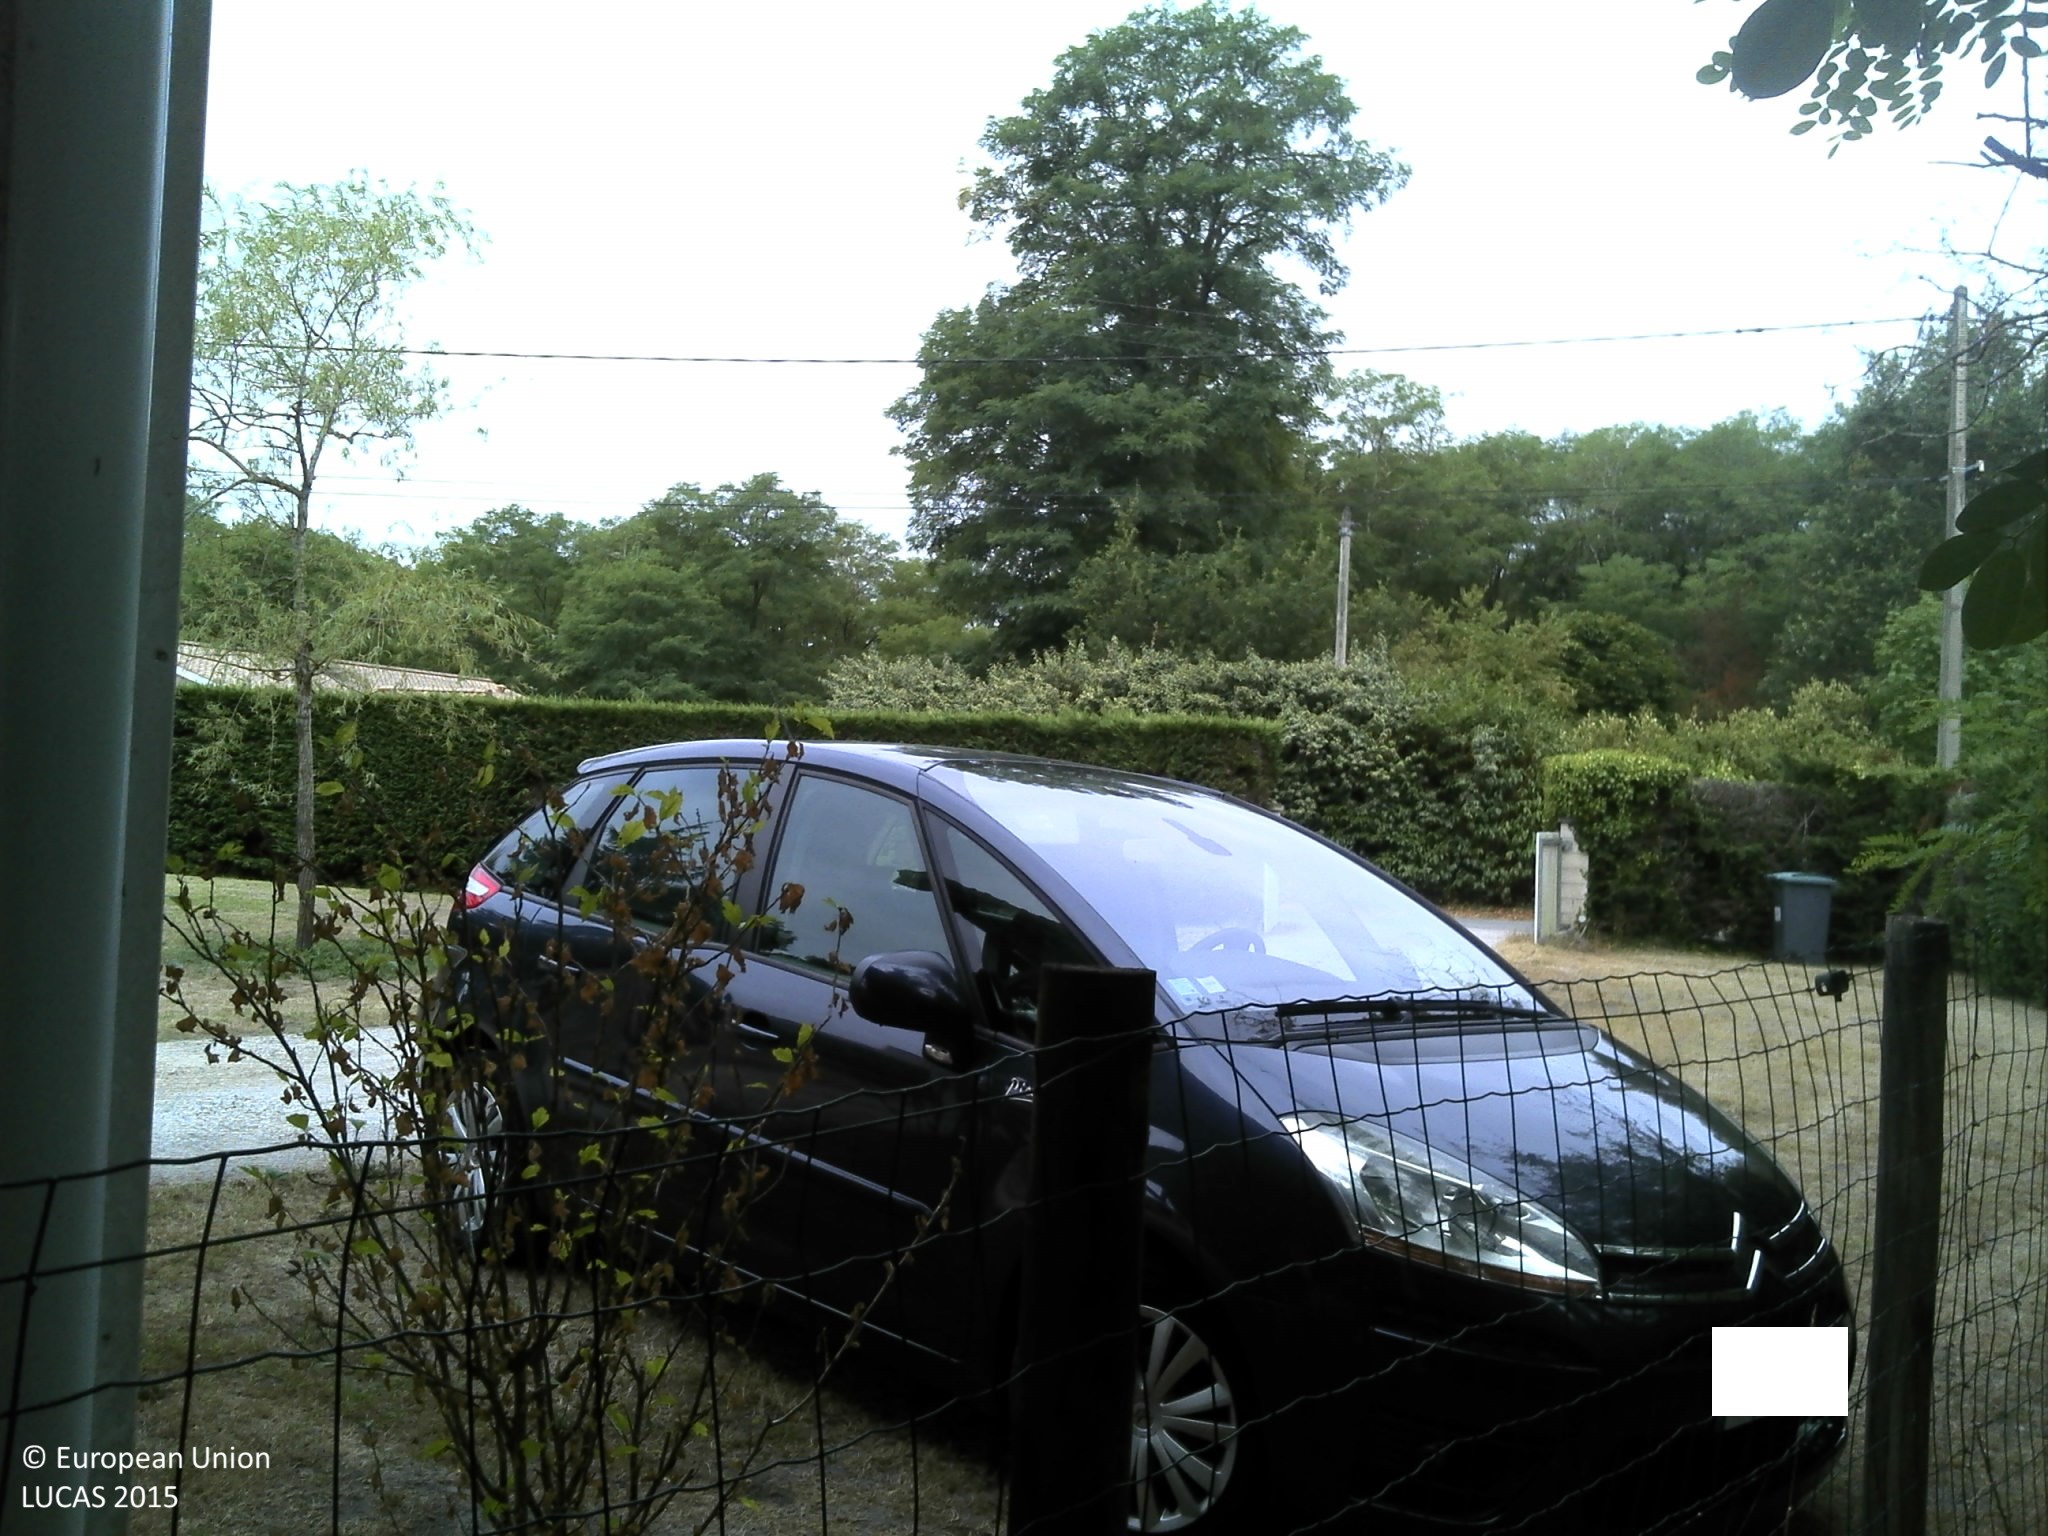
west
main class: Woodland
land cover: Broadleaved woodland
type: mesophytic deciduous forest
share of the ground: > 75 %
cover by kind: broadleaved forest trees 80 %, shrubs 10 %, herbaceous plants 5 %, lichens and mosses 5 %
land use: Semi-natural and natural areas not in use
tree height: > 5 m
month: July
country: FR
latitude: 44.6427
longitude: -0.5954
